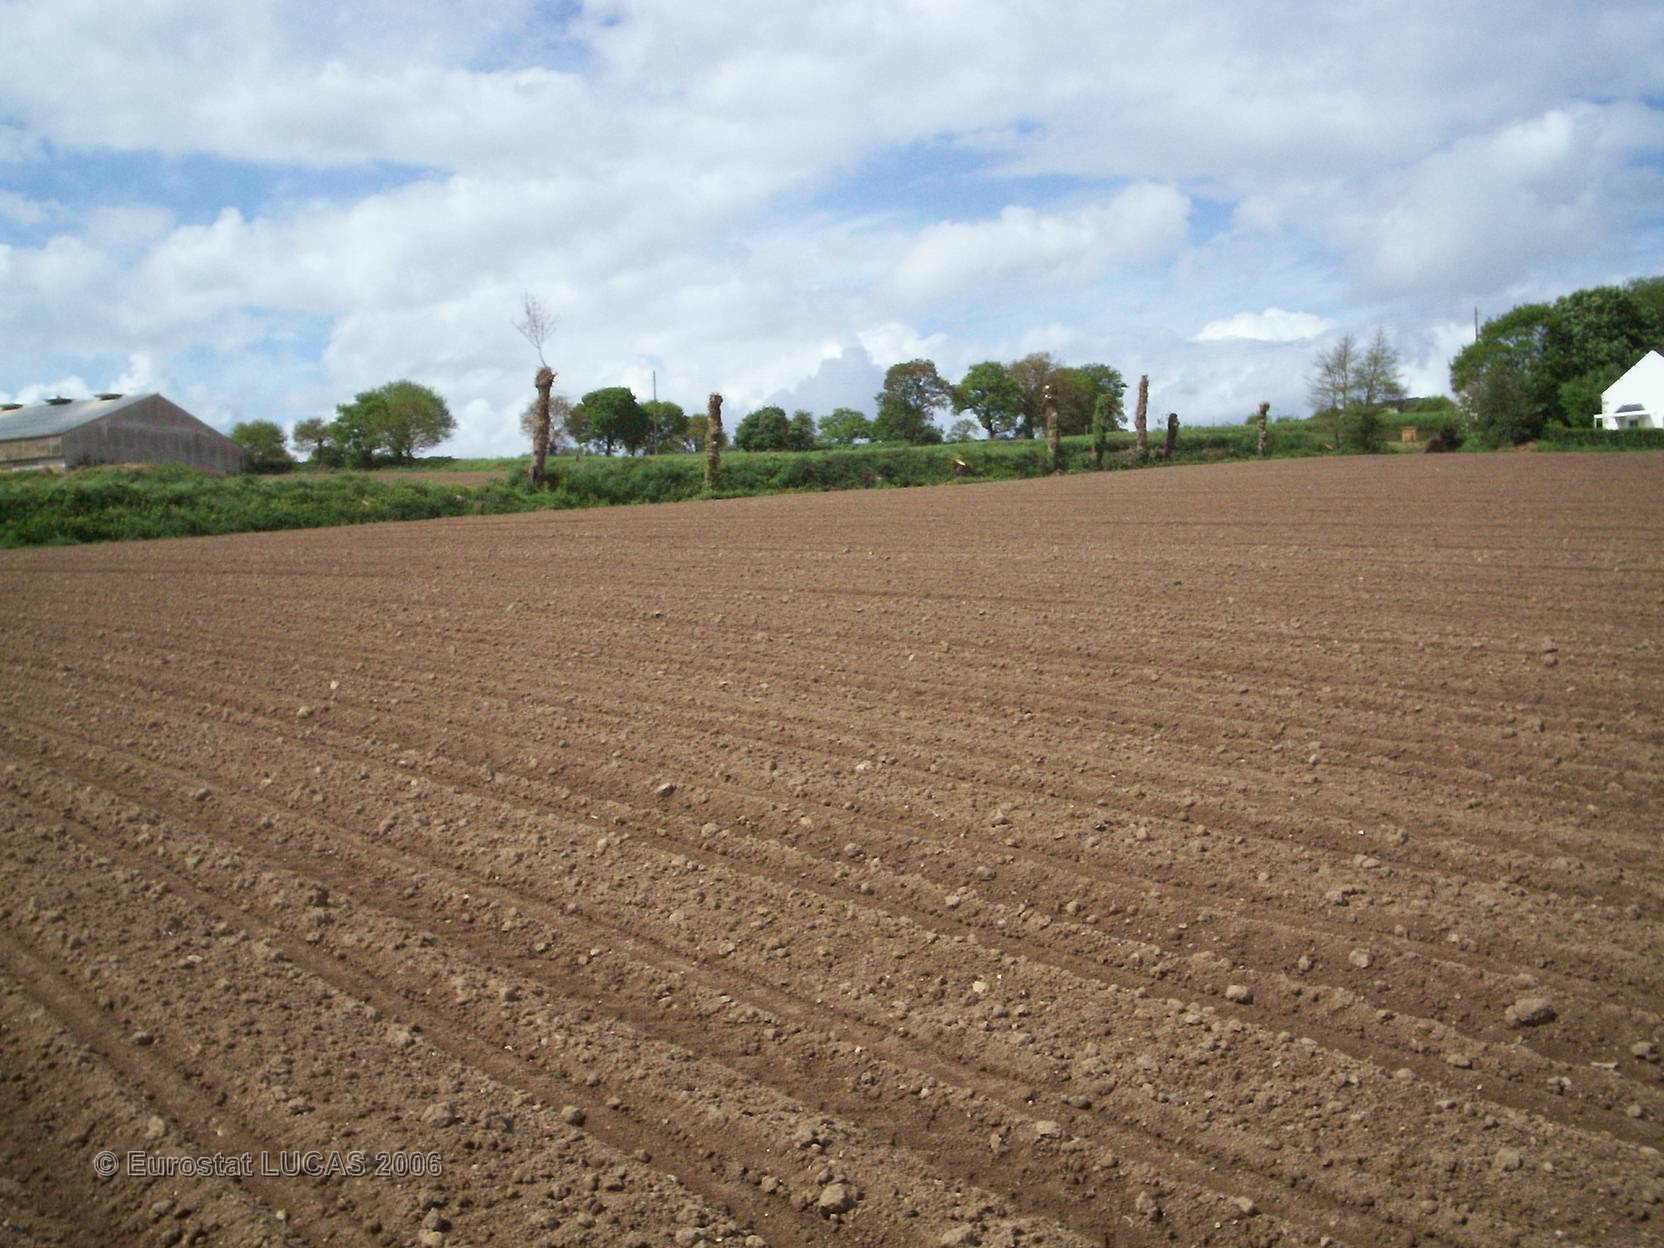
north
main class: Cropland
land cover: Maize
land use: Agriculture (excluding fallow land and kitchen gardens)
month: May
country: FR
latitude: 48.4636
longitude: -2.9025
